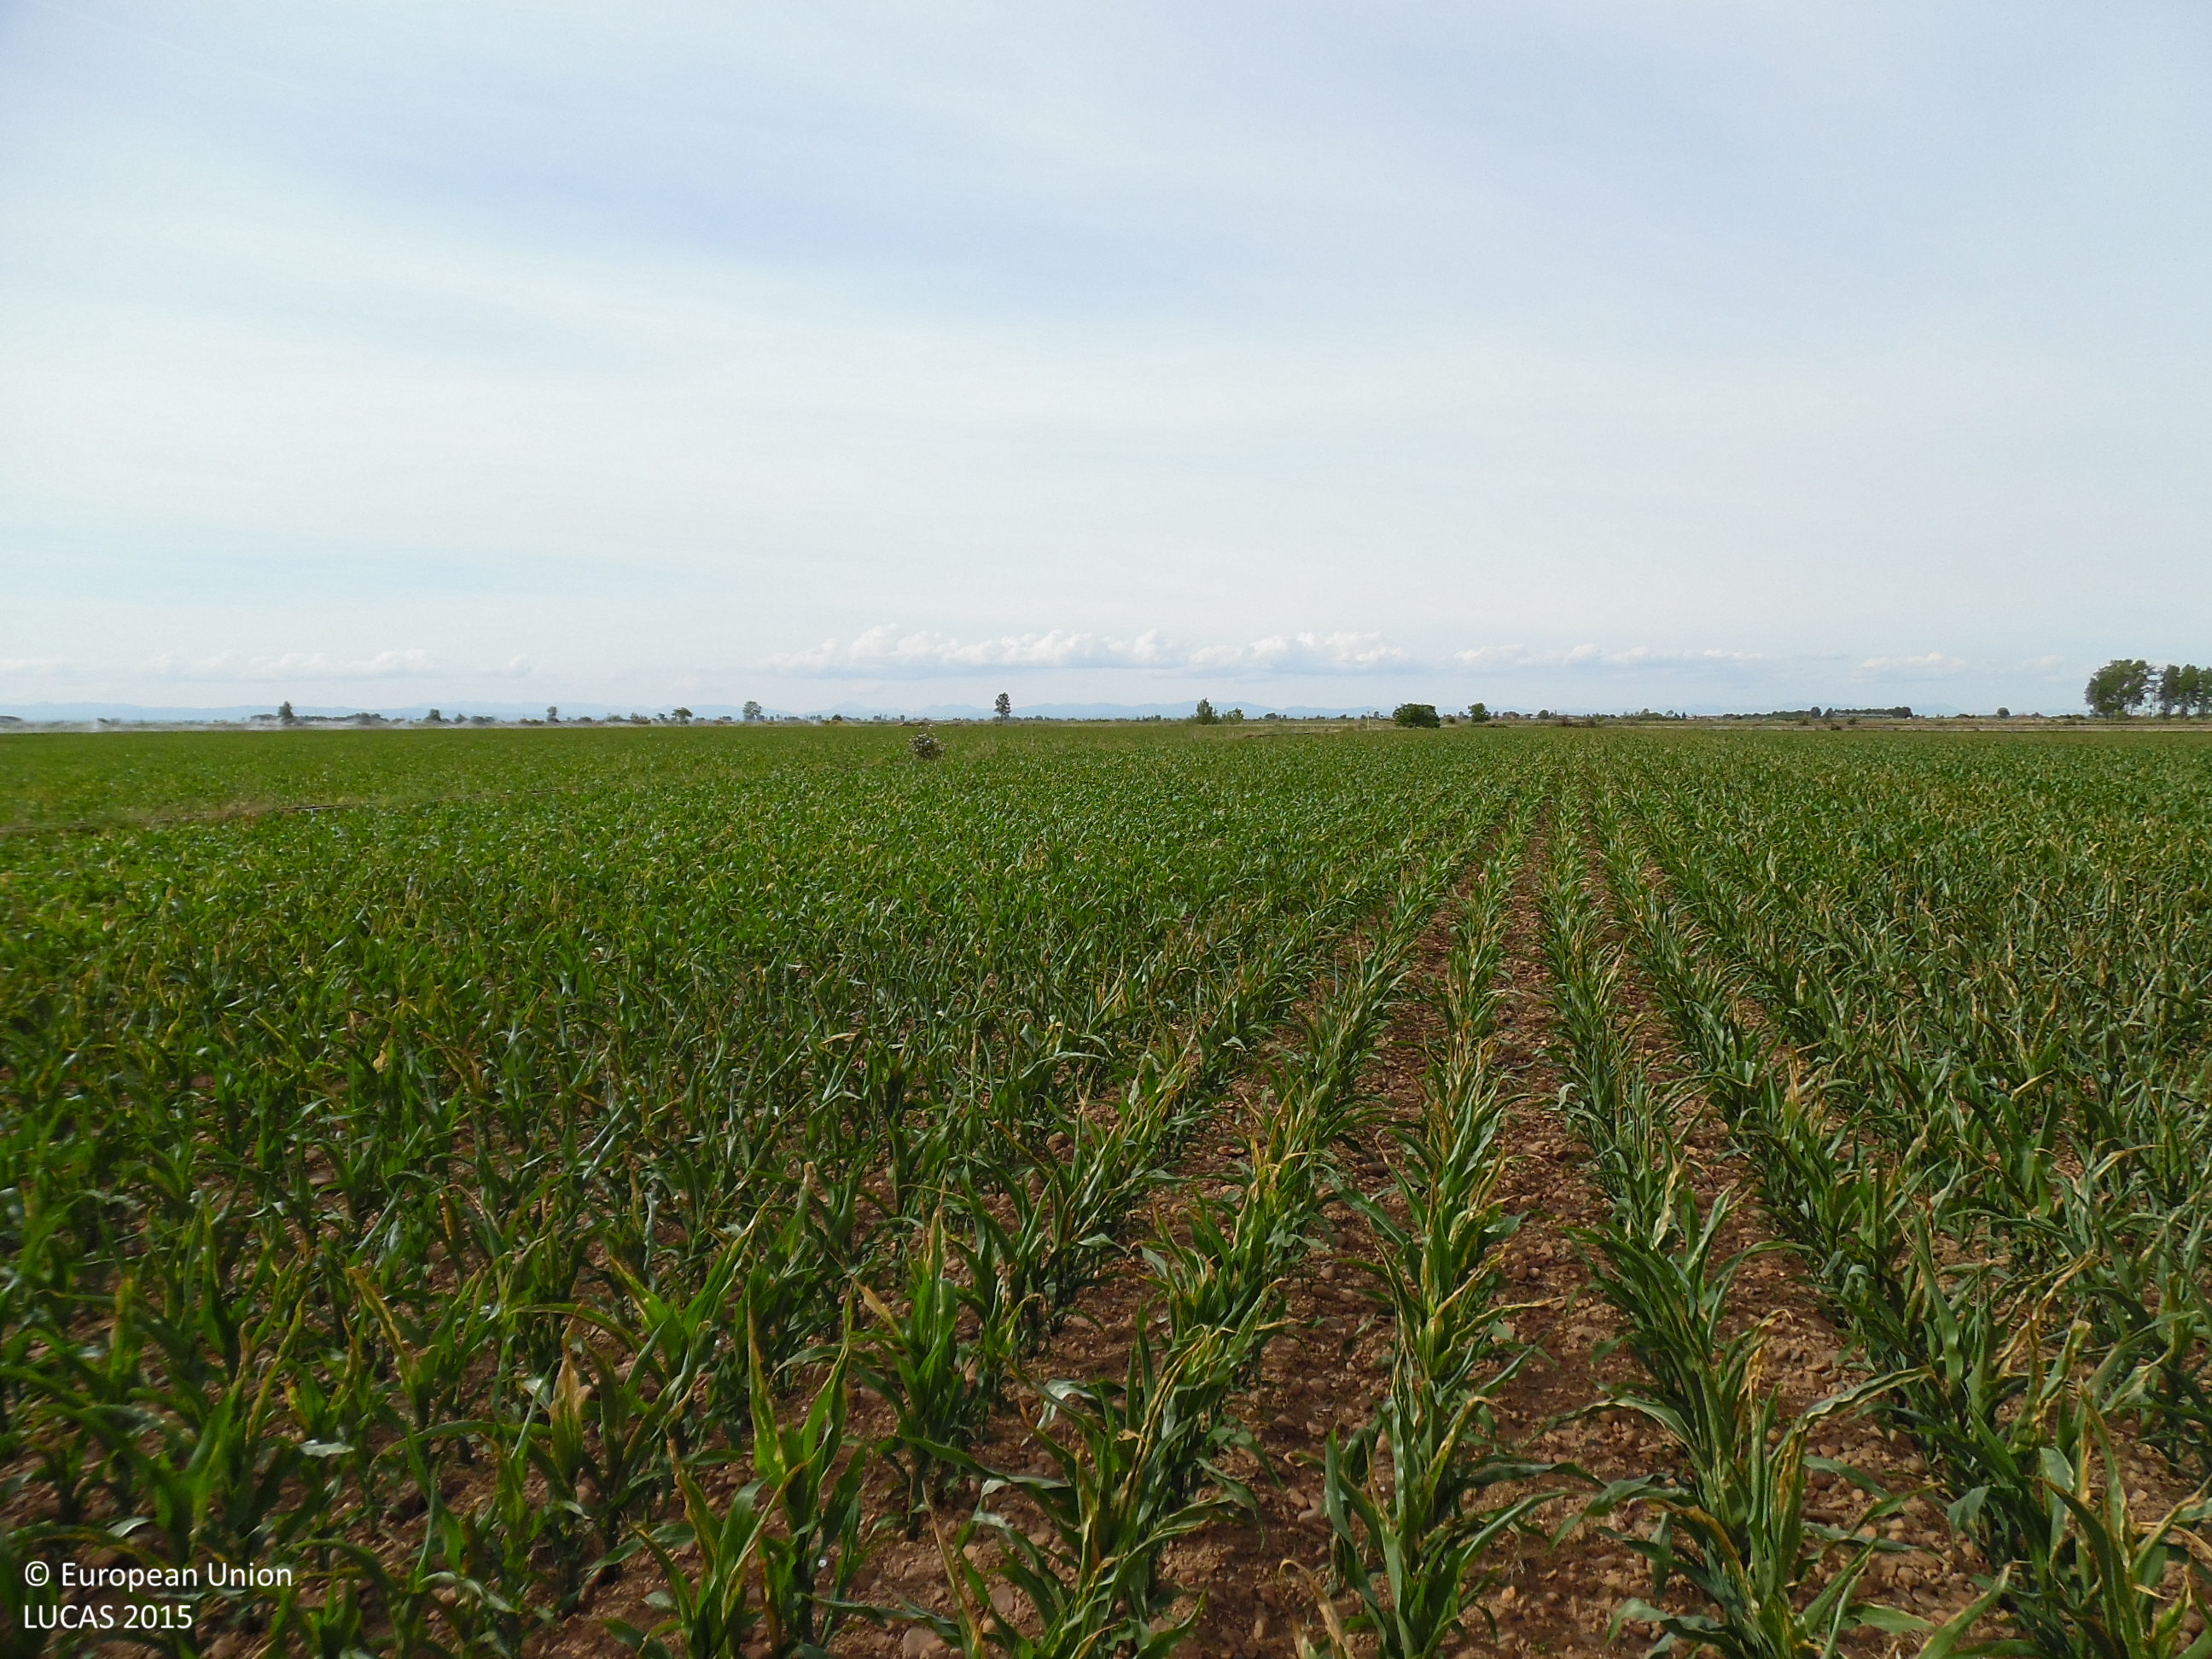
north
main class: Cropland
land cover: Maize
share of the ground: 50 - 75 %
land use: Agriculture (excluding fallow land and kitchen gardens)
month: June
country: ES
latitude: 42.3677
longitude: -5.7503
